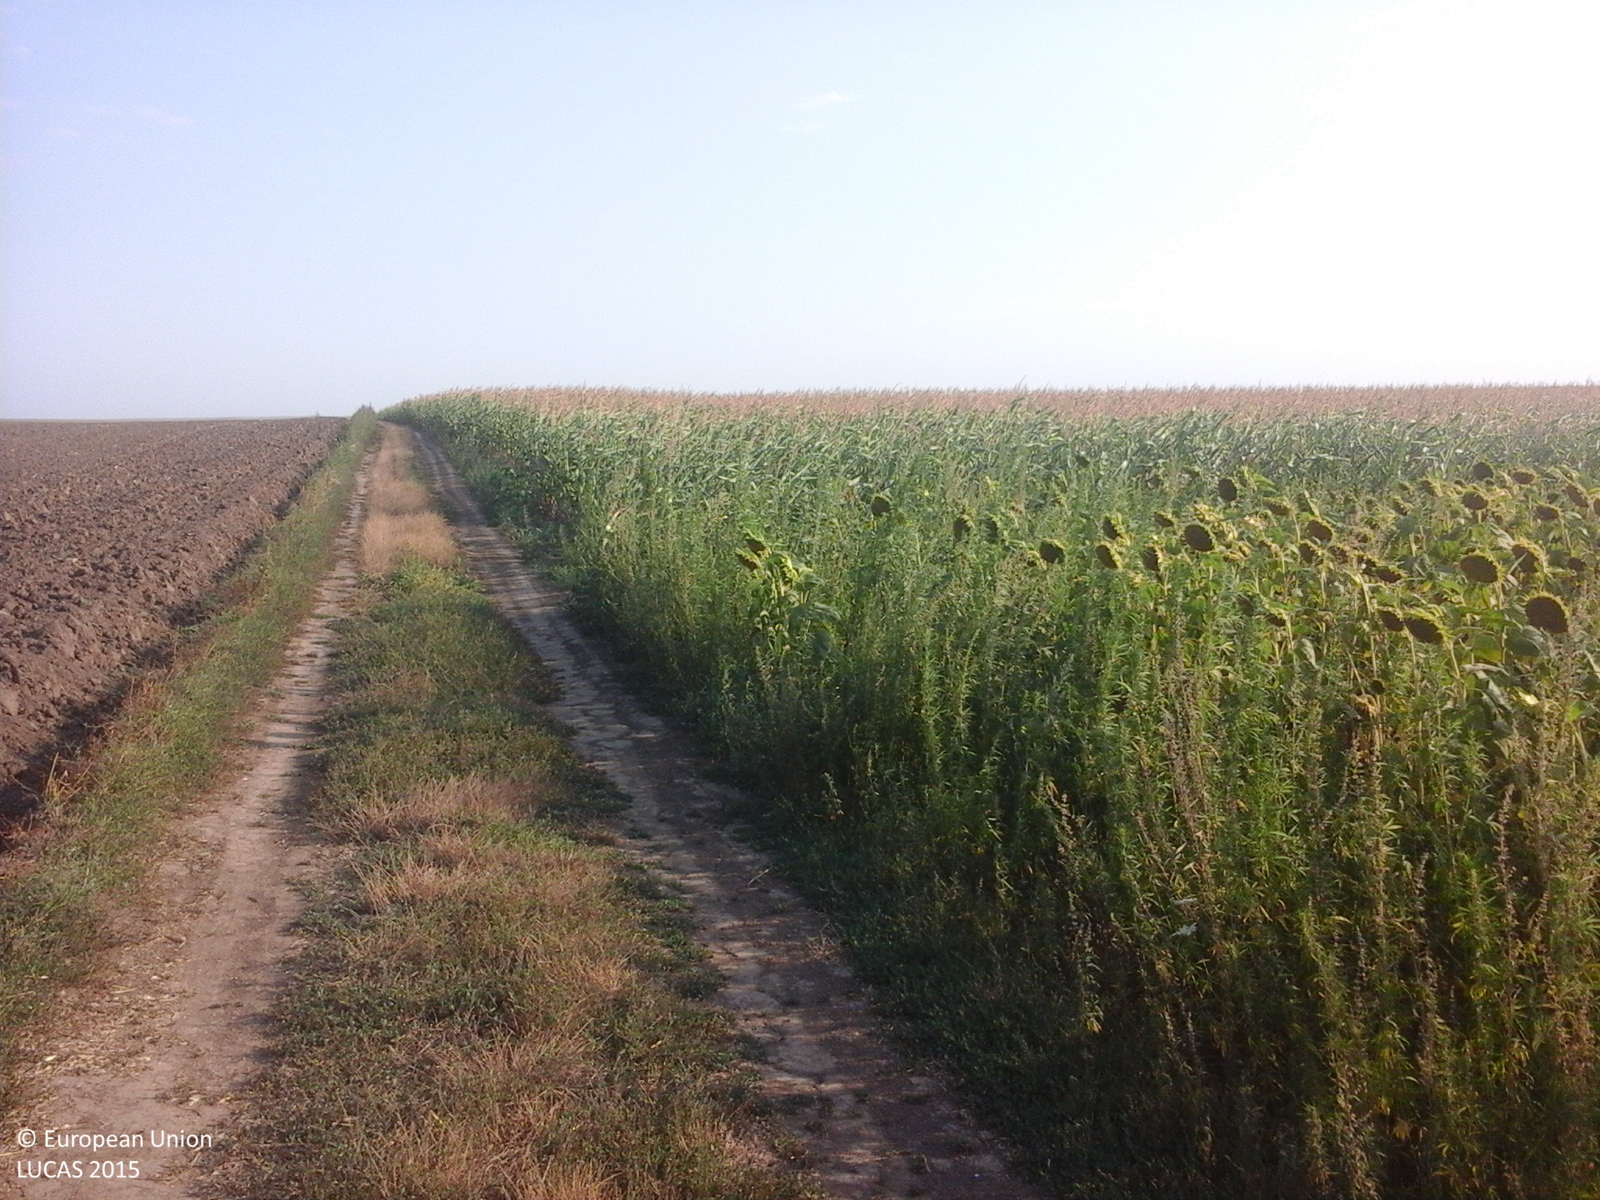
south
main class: Cropland
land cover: Sunflower
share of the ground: > 75 %
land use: Agriculture (excluding fallow land and kitchen gardens)
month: August
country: RO
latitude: 44.0755
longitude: 28.0735
